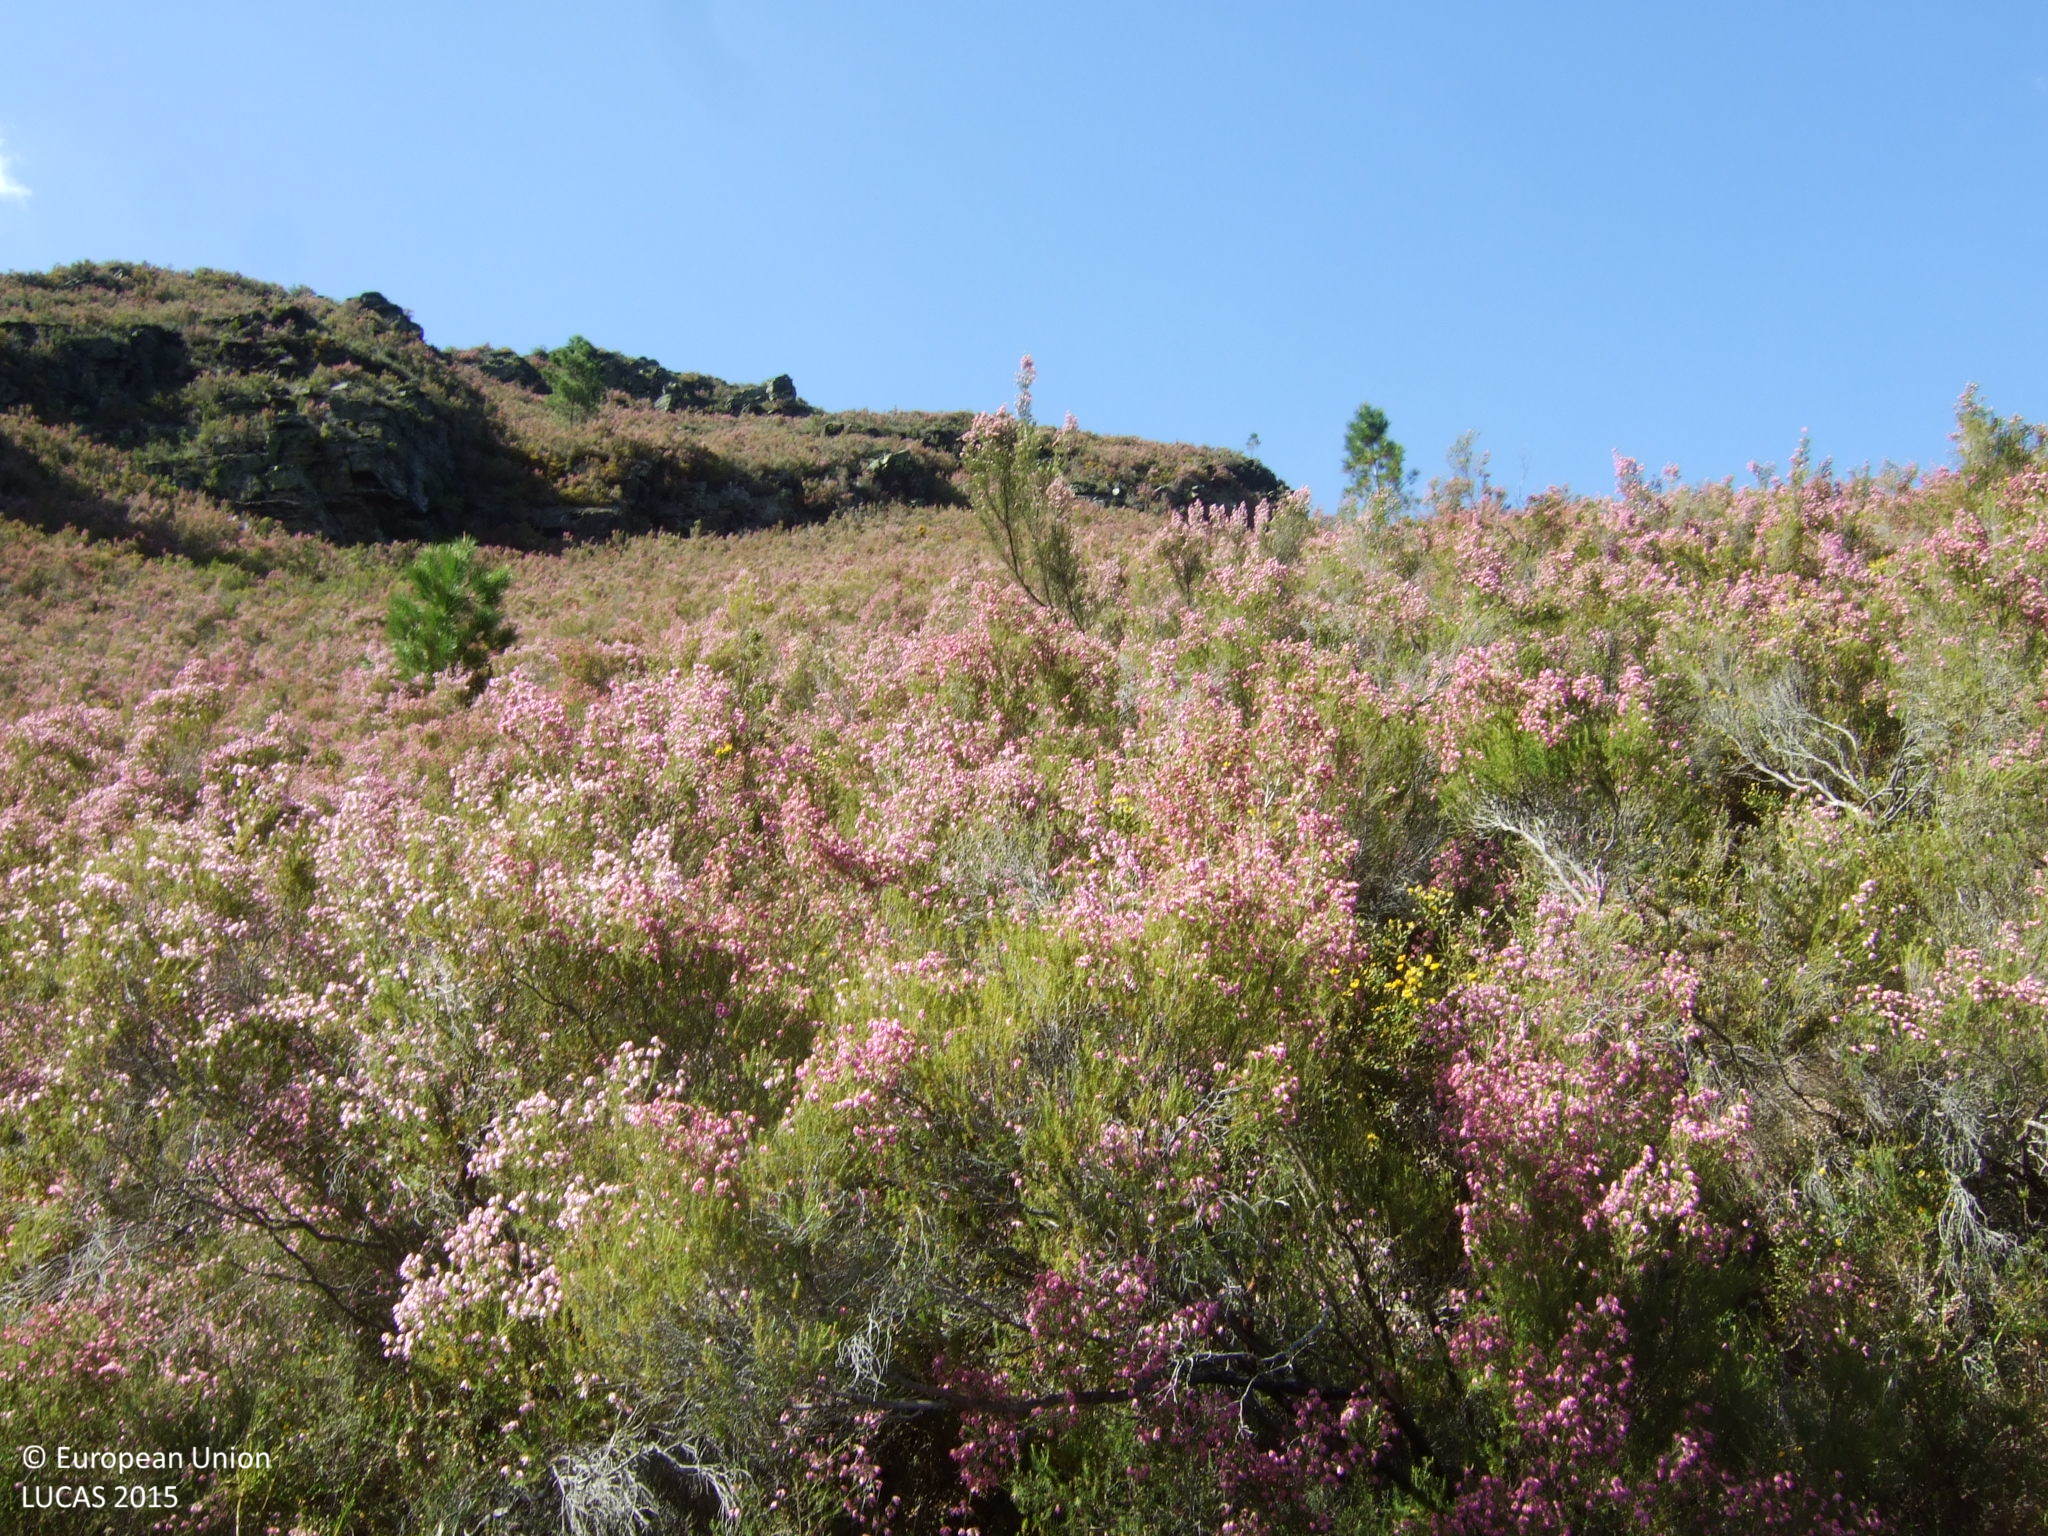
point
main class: Shrubland
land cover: Shrubland without tree cover
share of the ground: > 75 %
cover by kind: shrubs 100 %
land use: Semi-natural and natural areas not in use
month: April
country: ES
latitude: 42.6136
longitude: -7.2653
